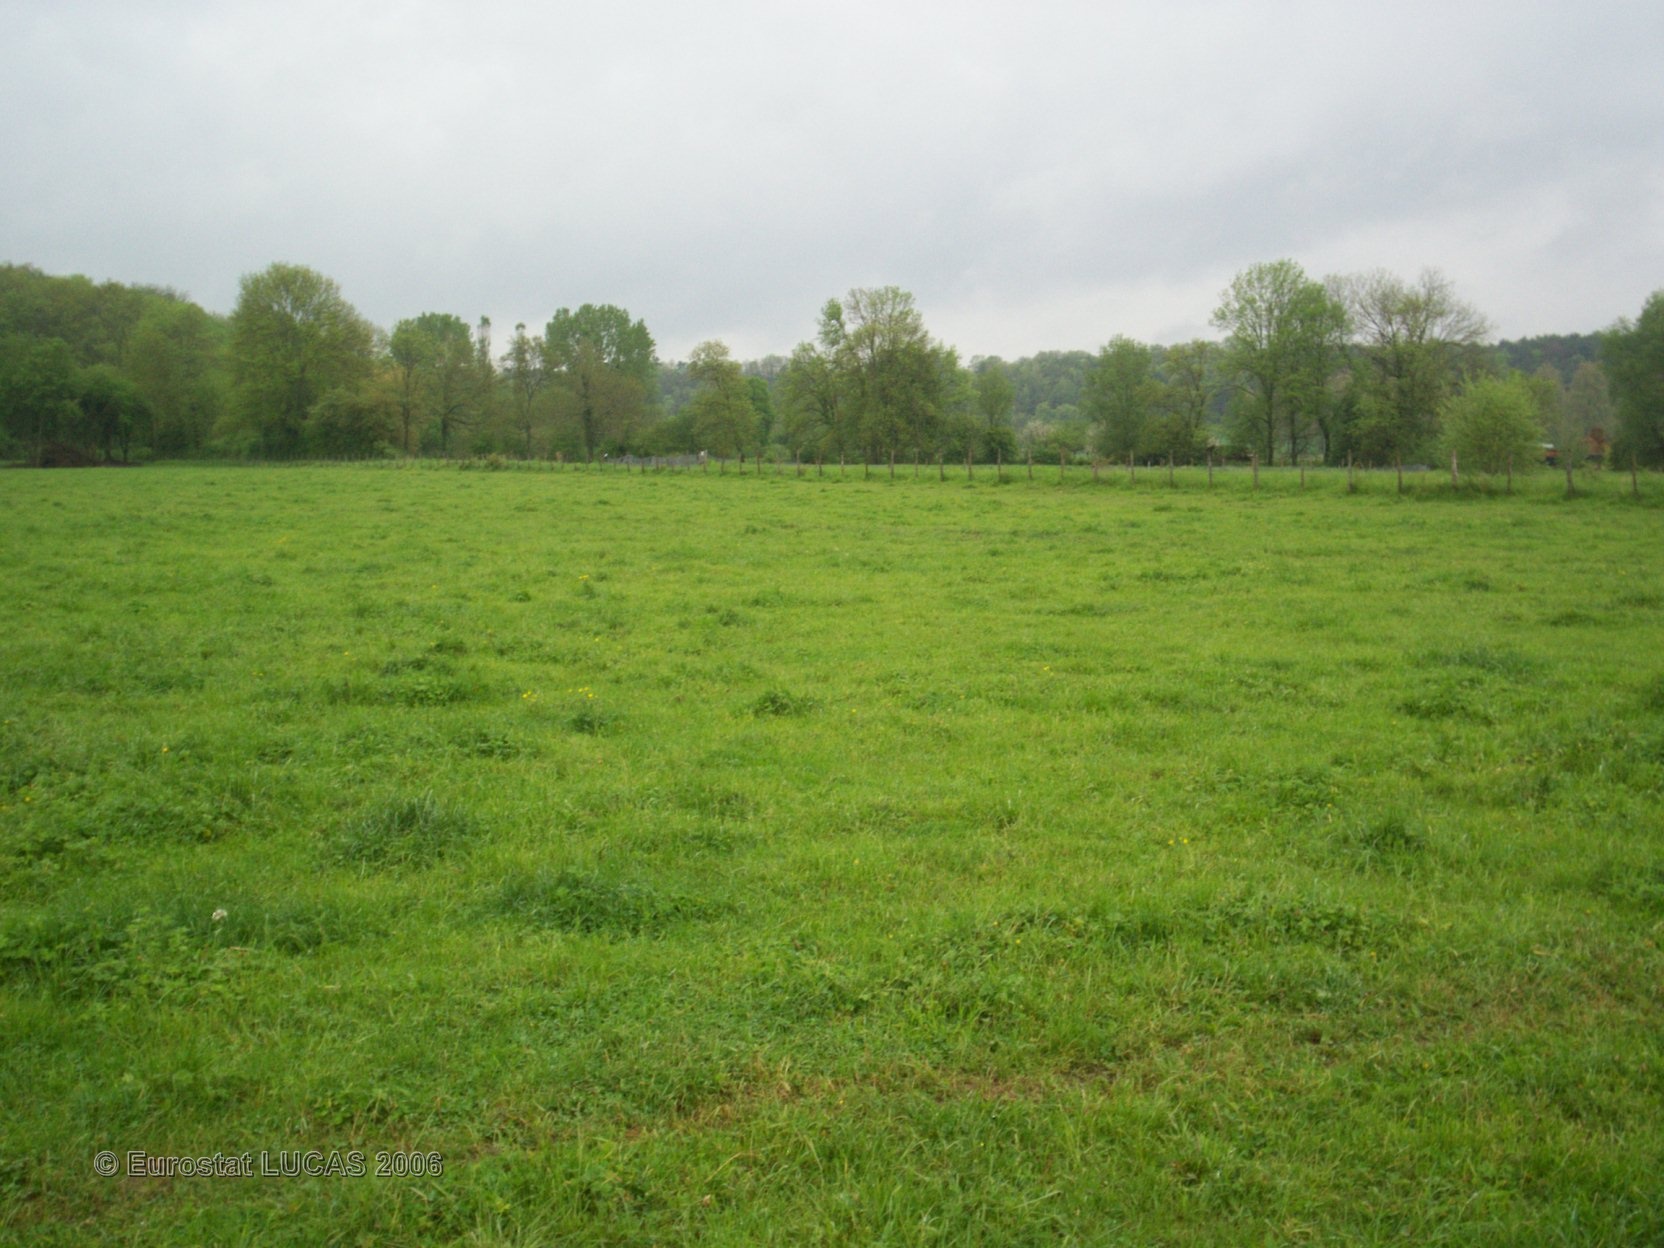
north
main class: Grassland
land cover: Grassland without tree/shrub cover
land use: Agriculture (excluding fallow land and kitchen gardens)
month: May
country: FR
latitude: 47.7650
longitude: 4.5684
